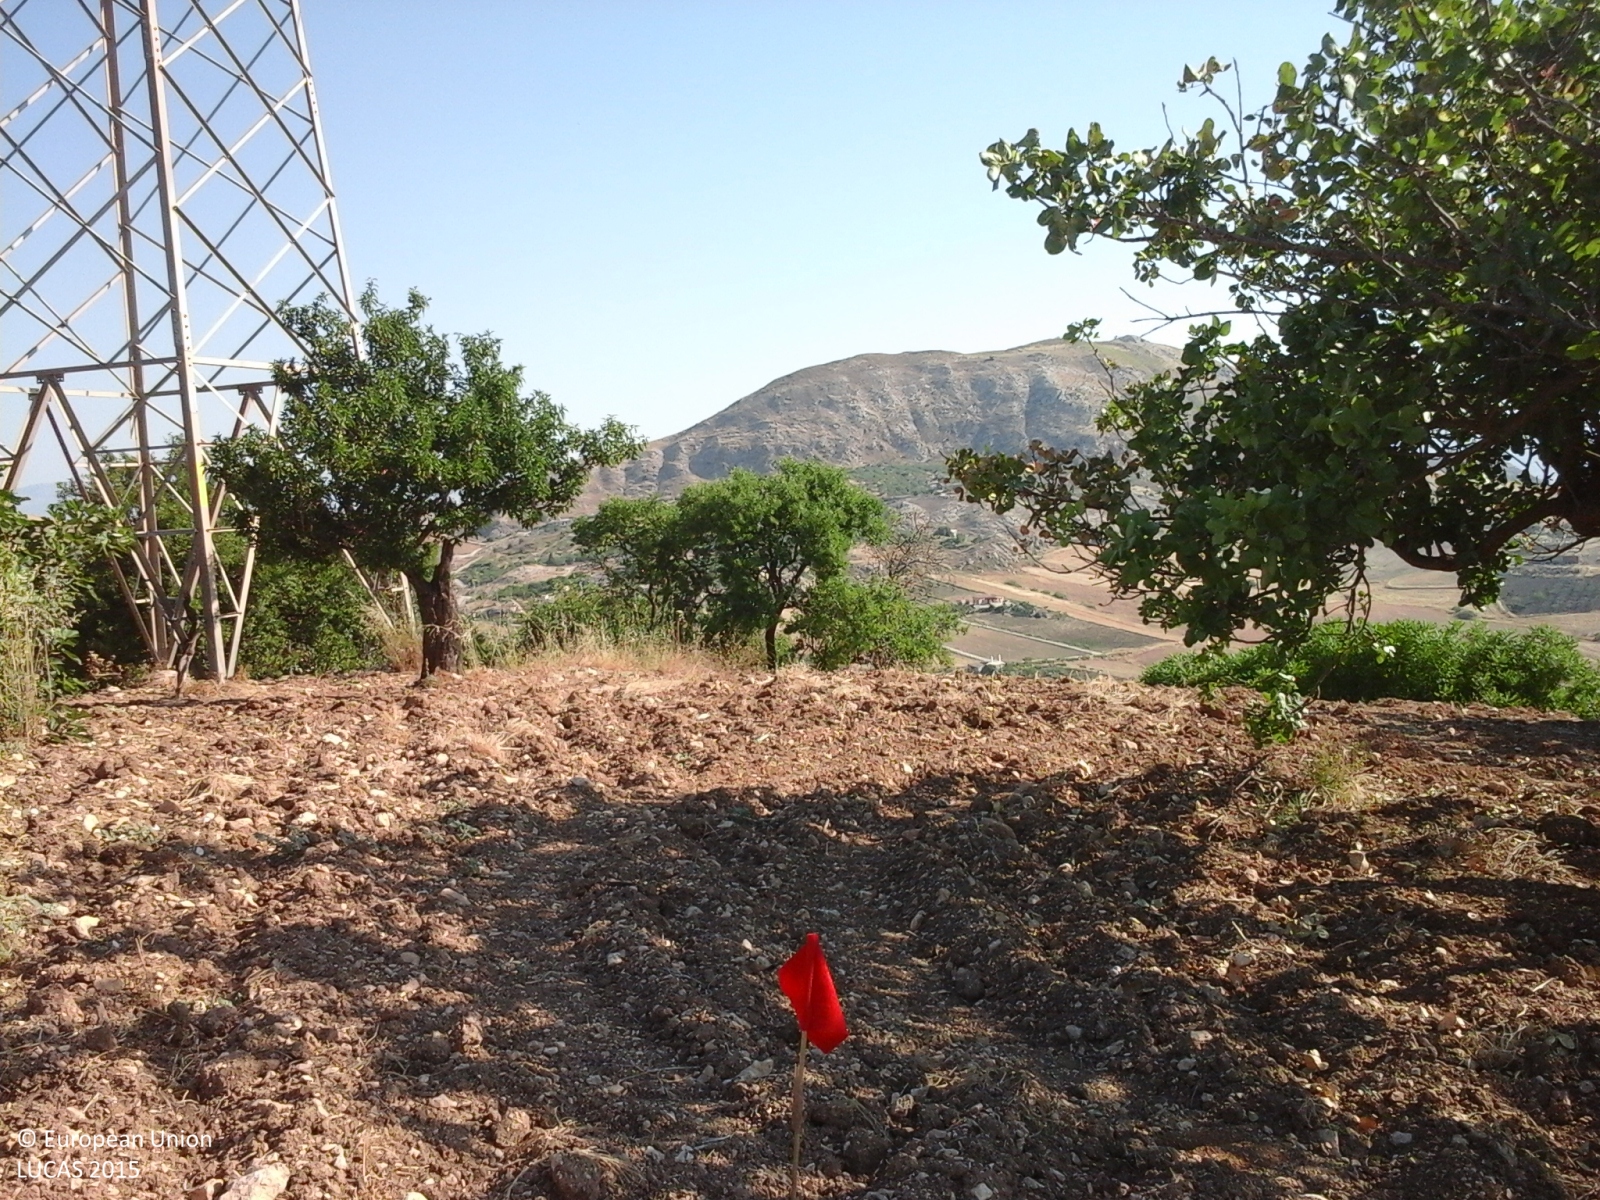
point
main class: Cropland
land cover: Nuts trees
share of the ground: 25 - 50 %
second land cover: Other bare soil
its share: > 75 %
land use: Agriculture (excluding fallow land and kitchen gardens)
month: July
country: IT
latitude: 37.4284
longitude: 13.5101
